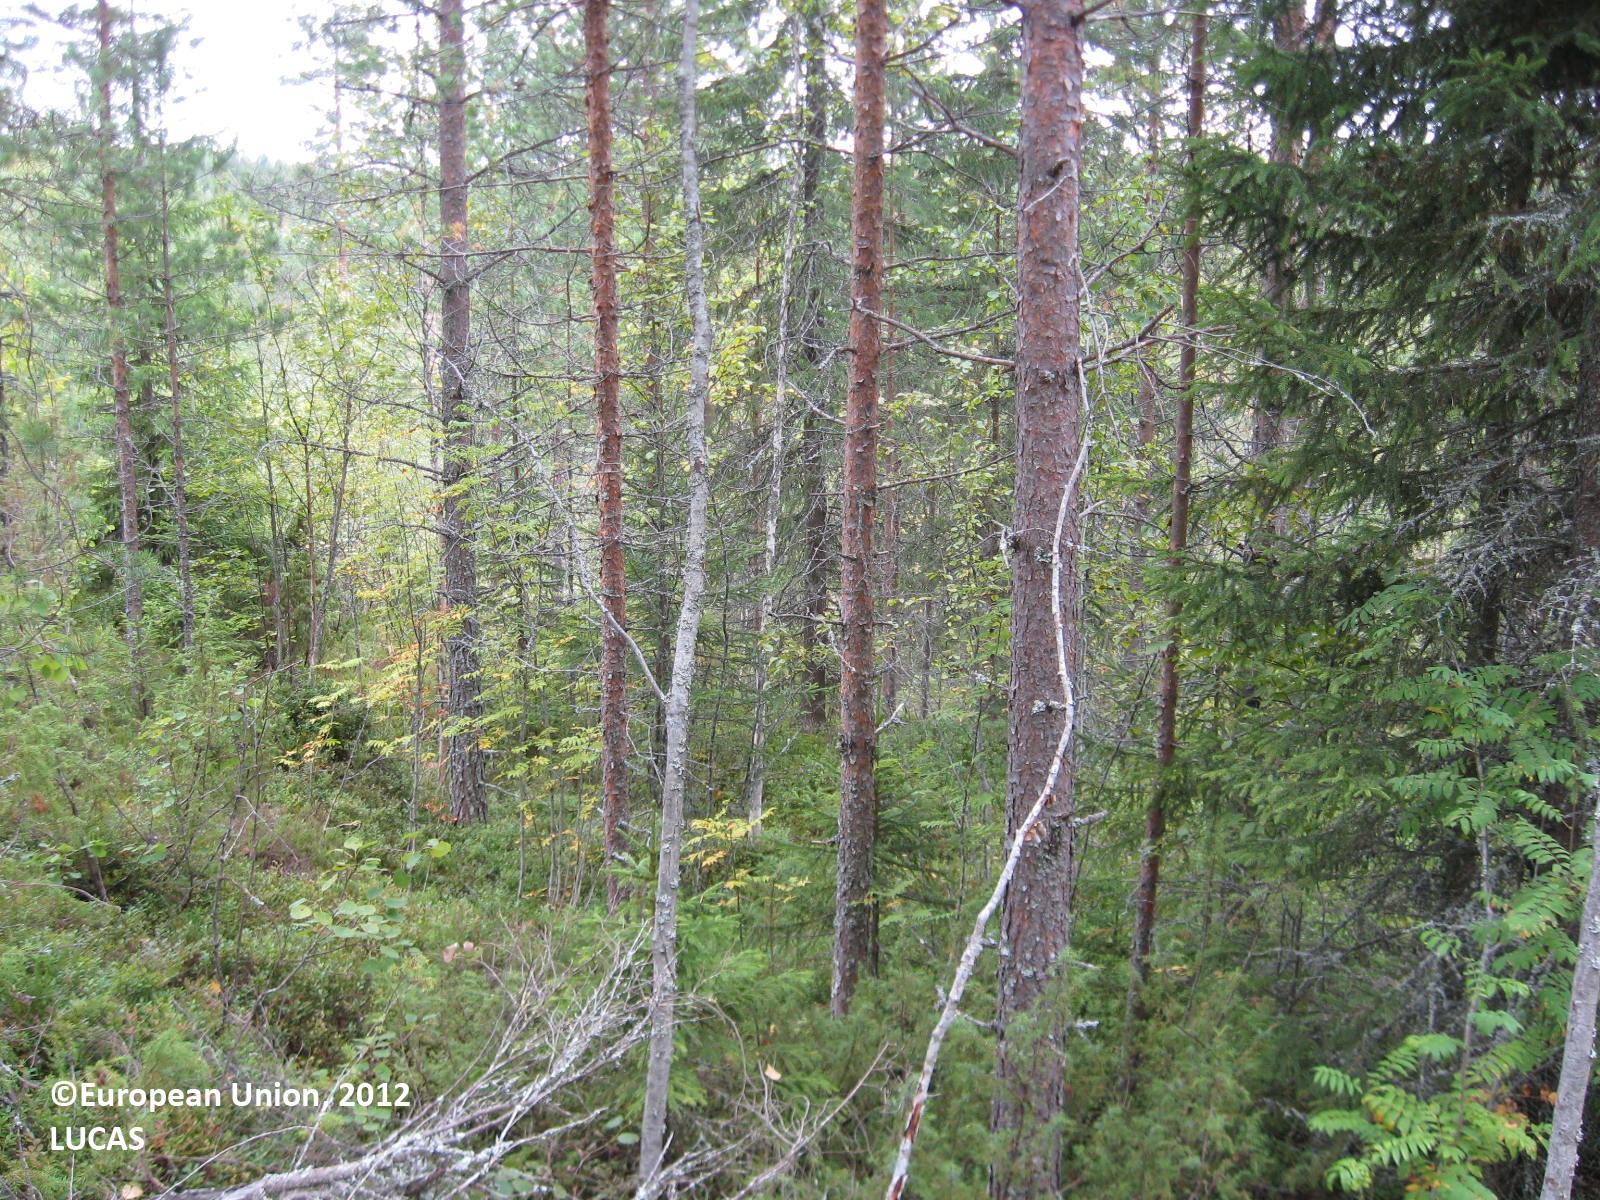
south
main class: Woodland
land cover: Pine dominated mixed woodland
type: boreal forest
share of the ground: 50 - 75 %
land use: Forestry
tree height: > 5 m
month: August
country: FI
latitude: 63.6827
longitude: 29.2808
